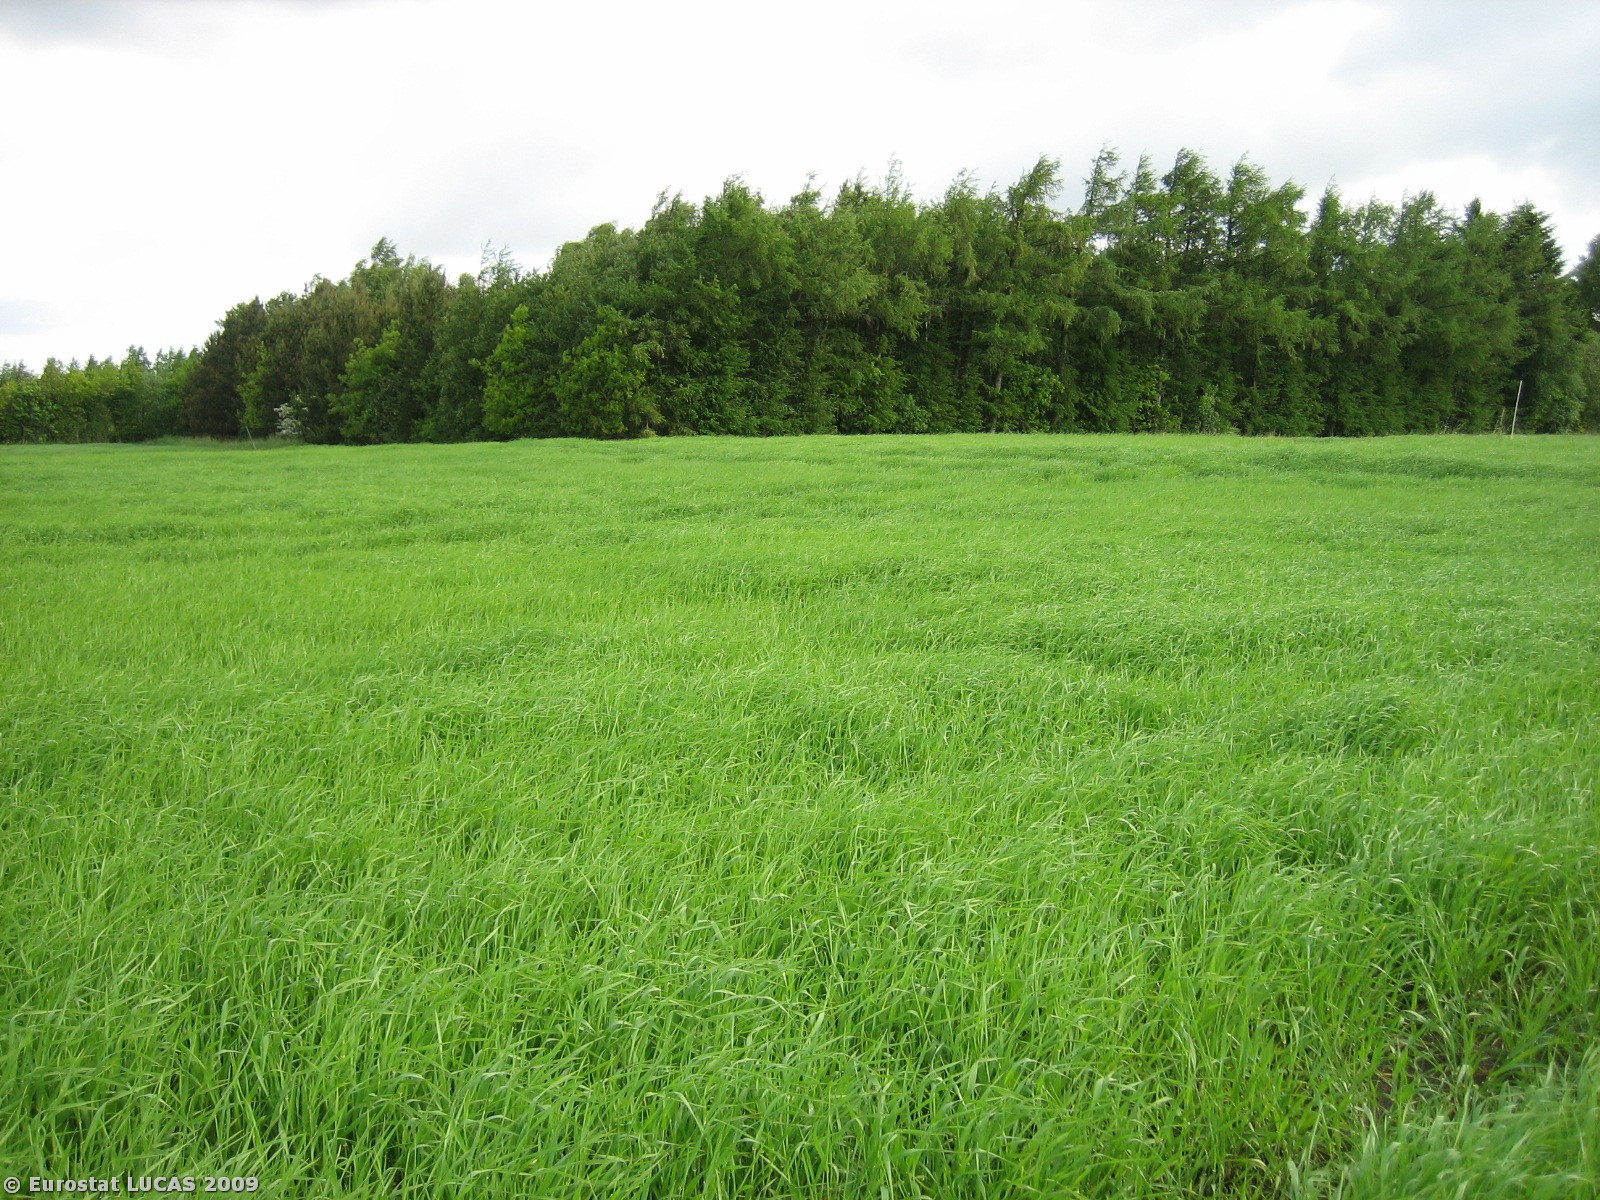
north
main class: Cropland
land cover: Barley
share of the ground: > 75 %
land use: Agriculture (excluding fallow land and kitchen gardens)
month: May
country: DK
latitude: 55.8977
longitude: 9.2172
